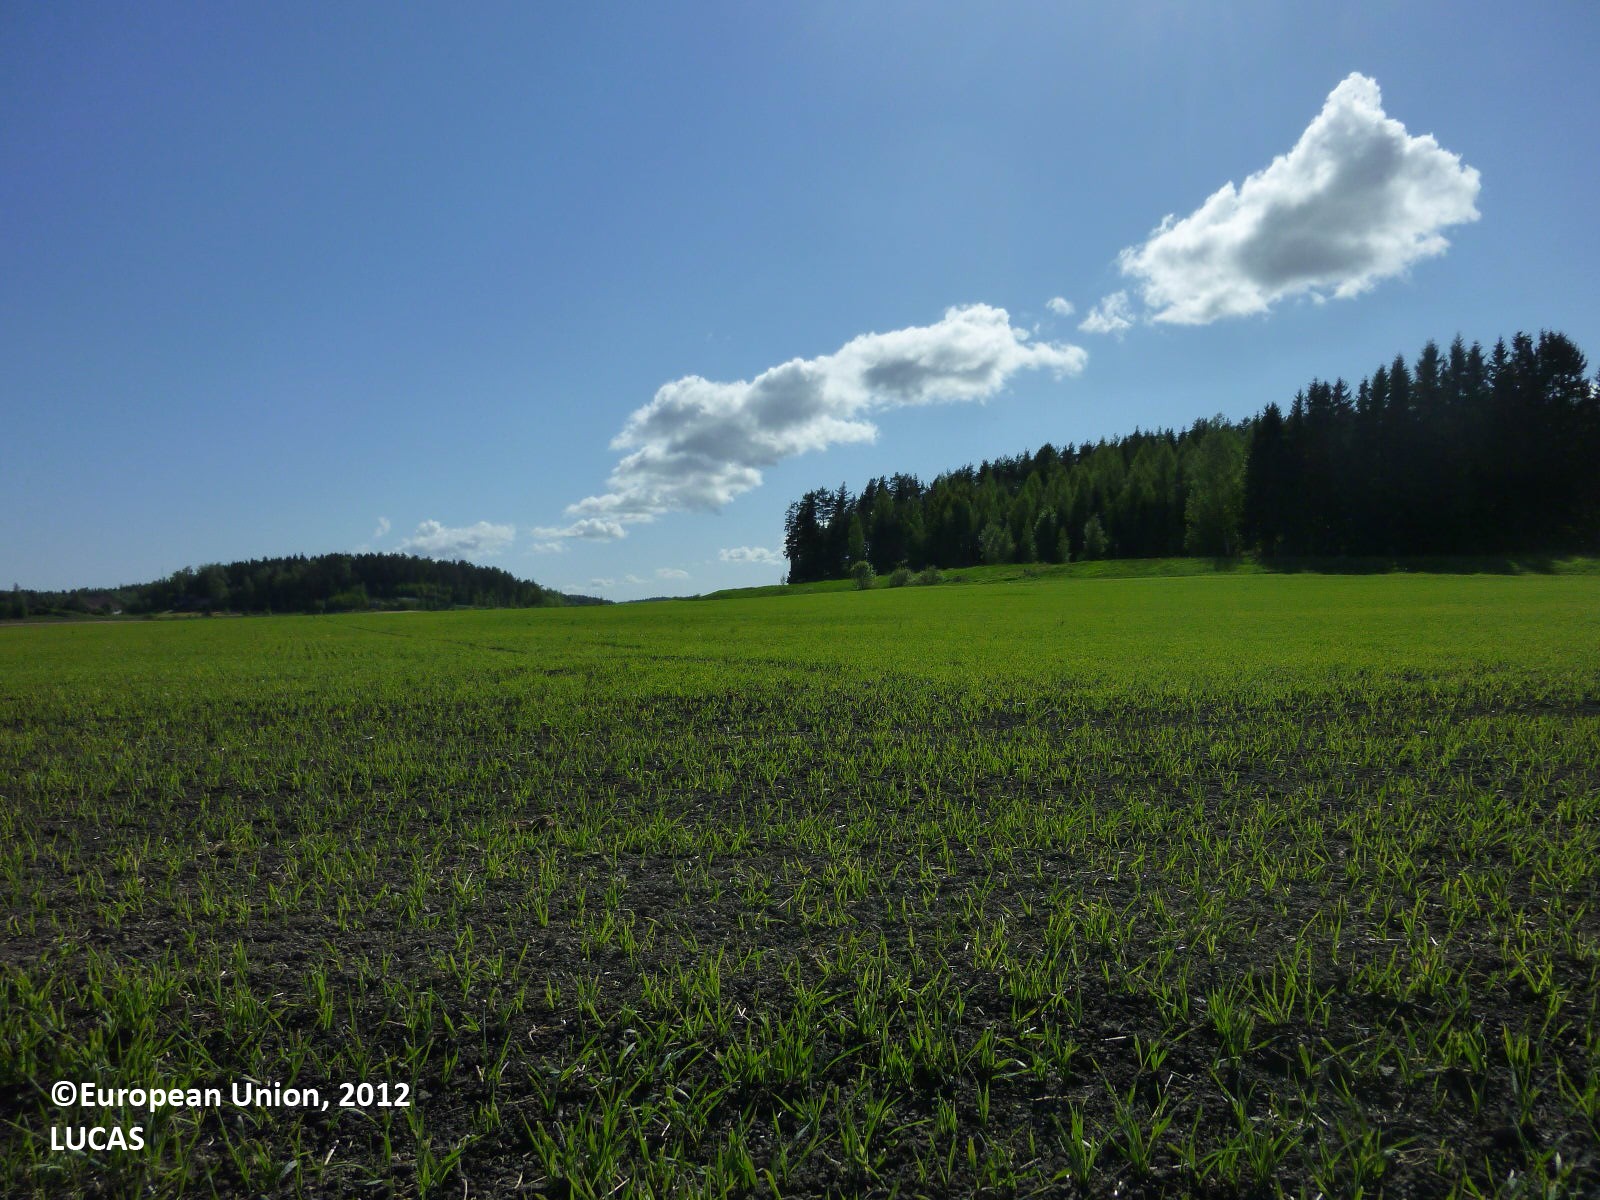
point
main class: Cropland
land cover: Barley
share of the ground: > 75 %
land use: Agriculture (excluding fallow land and kitchen gardens)
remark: Tilled/Sowed
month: June
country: FI
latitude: 60.4678
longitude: 22.6401
